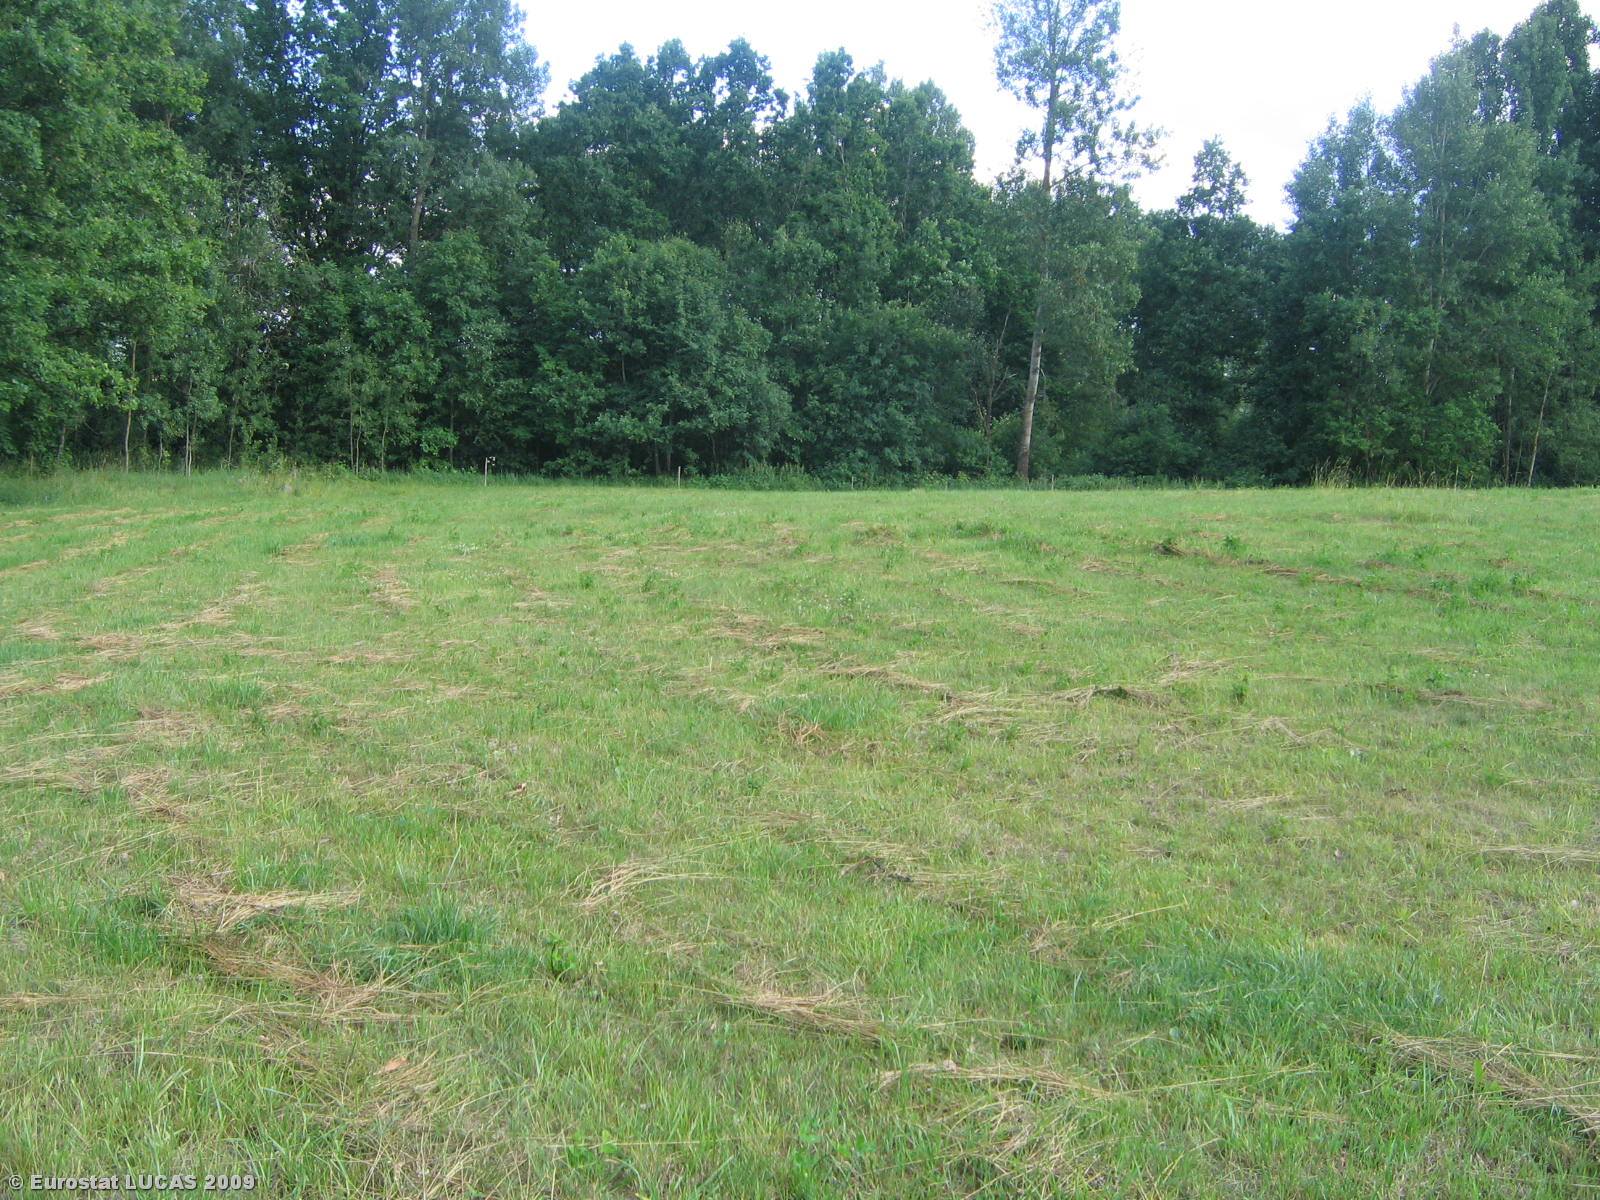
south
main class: Grassland
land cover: Grassland without tree/shrub cover
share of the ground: > 75 %
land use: Agriculture (excluding fallow land and kitchen gardens)
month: July
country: LT
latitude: 55.4093
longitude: 22.6841
